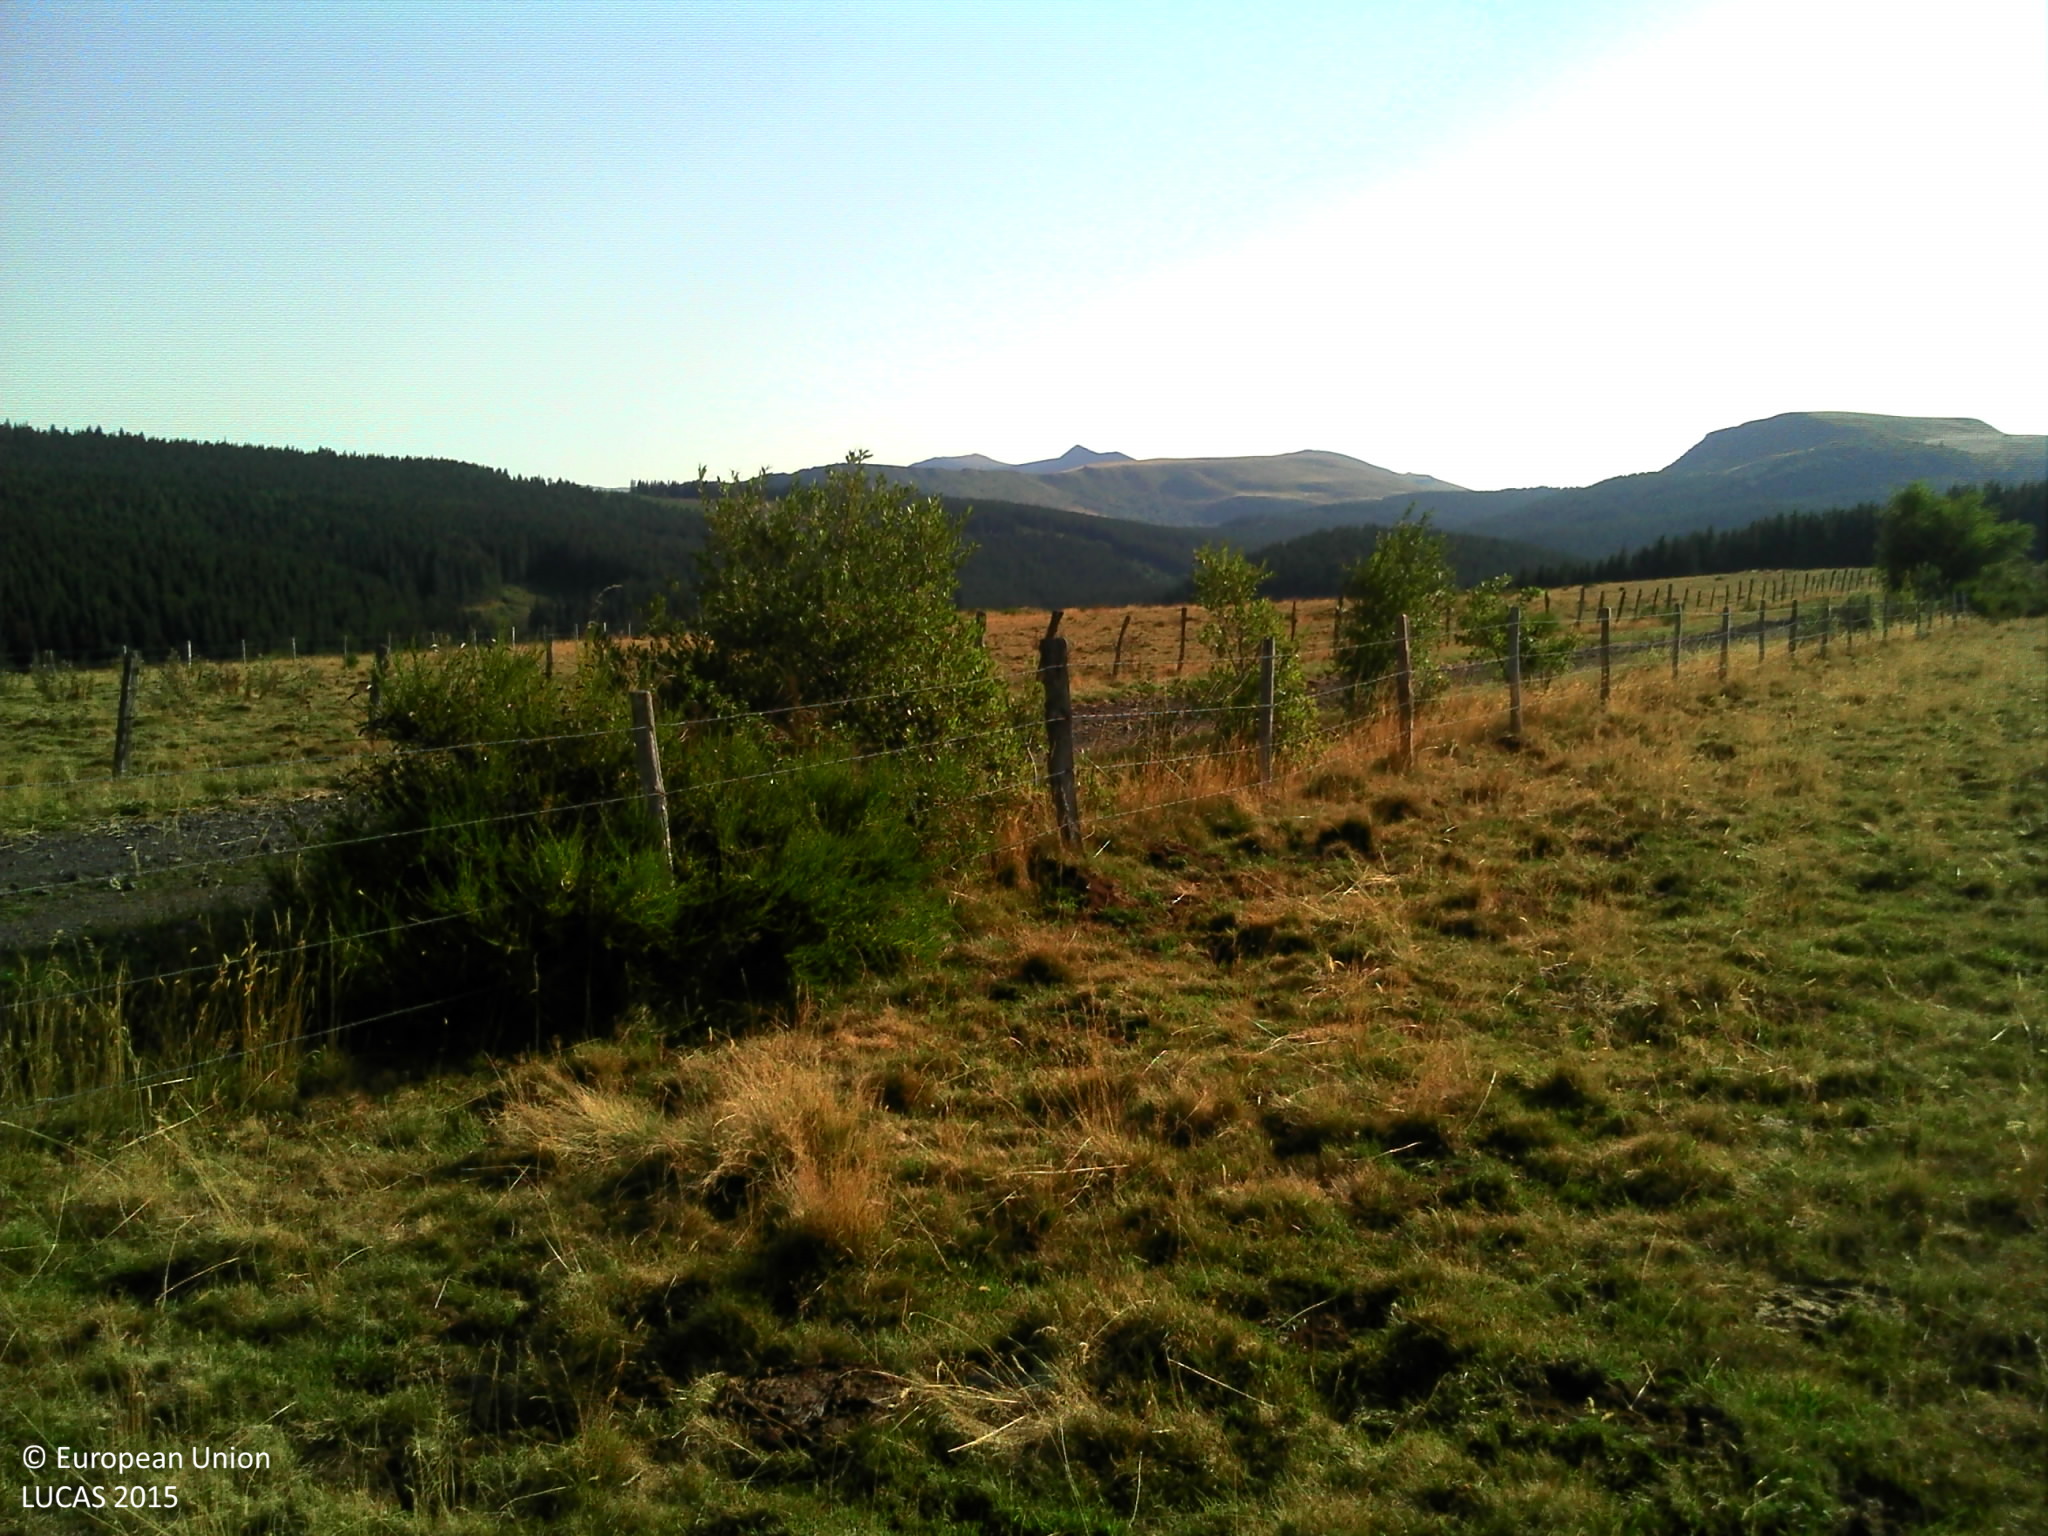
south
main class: Grassland
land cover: Grassland without tree/shrub cover
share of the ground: > 75 %
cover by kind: herbaceous plants 100 %
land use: Agriculture (excluding fallow land and kitchen gardens)
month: August
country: FR
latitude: 45.6274
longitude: 2.9065
